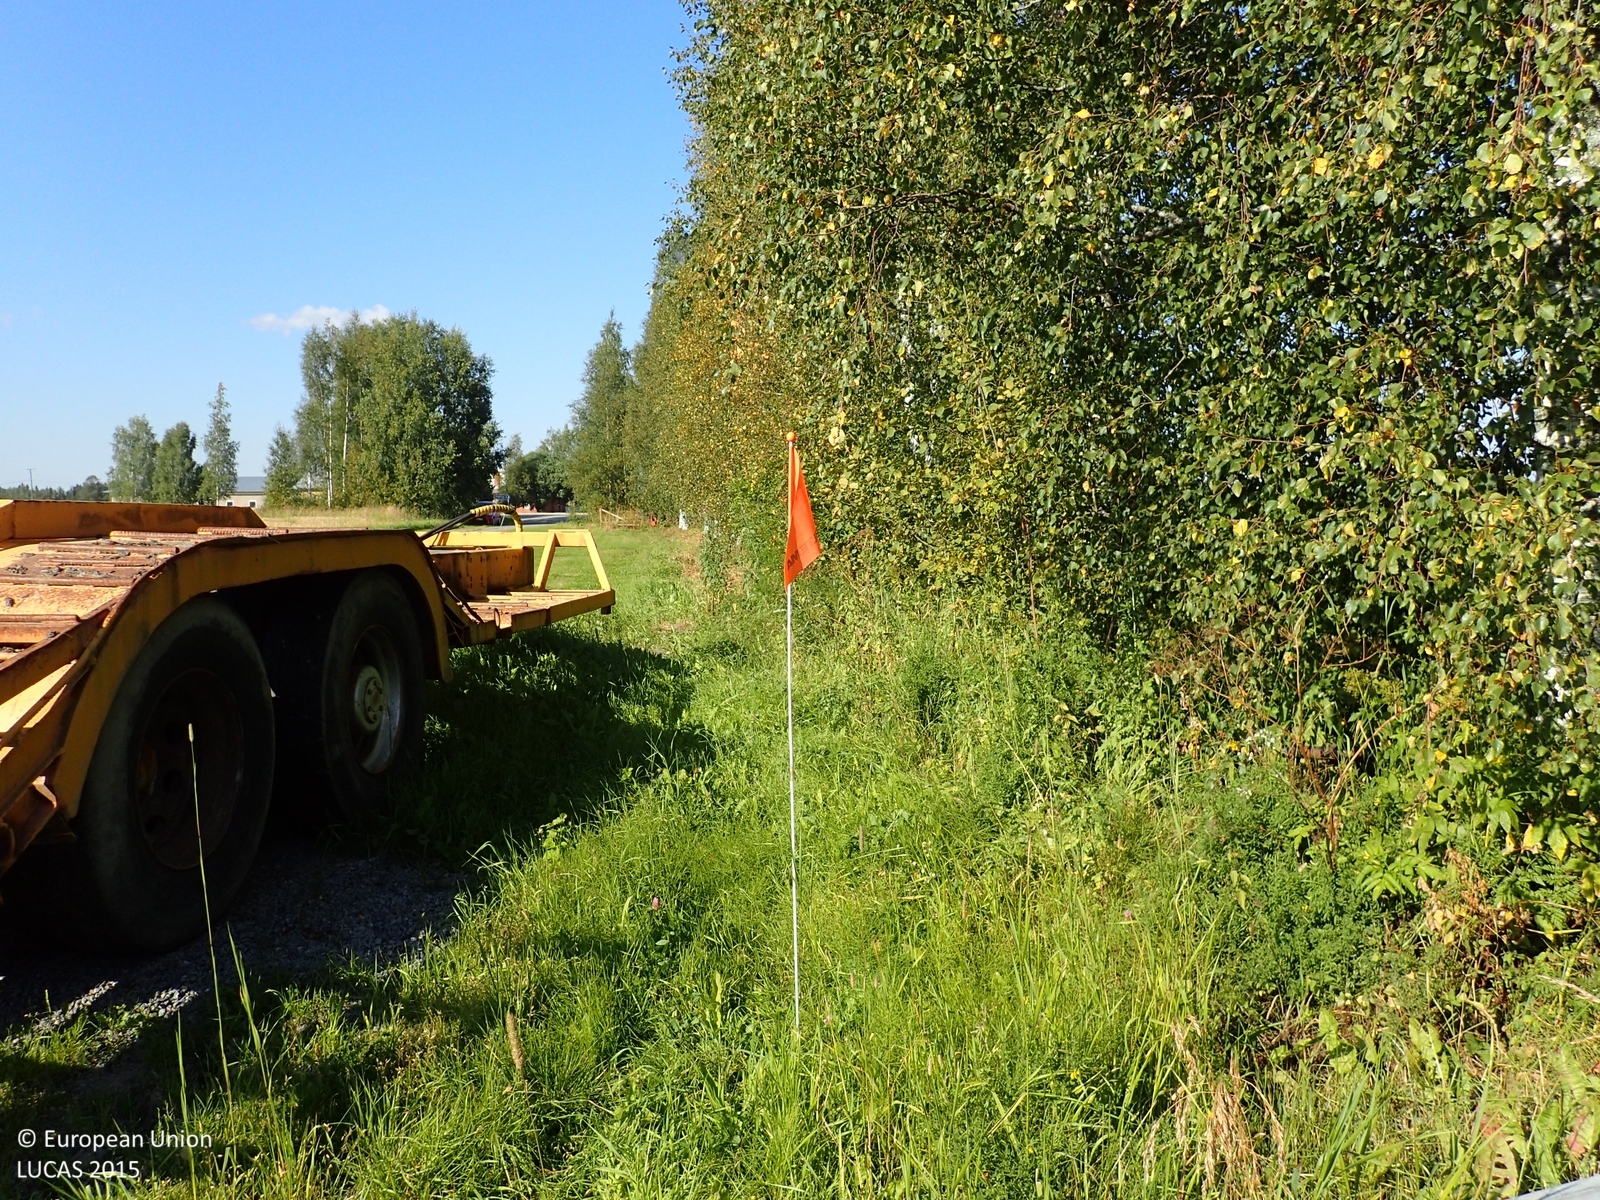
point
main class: Woodland
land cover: Broadleaved woodland
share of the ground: 25 - 50 %
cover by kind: herbaceous plants 60 %, broadleaved forest trees 40 %
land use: Residential
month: August
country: FI
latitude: 62.5123
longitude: 21.7961
